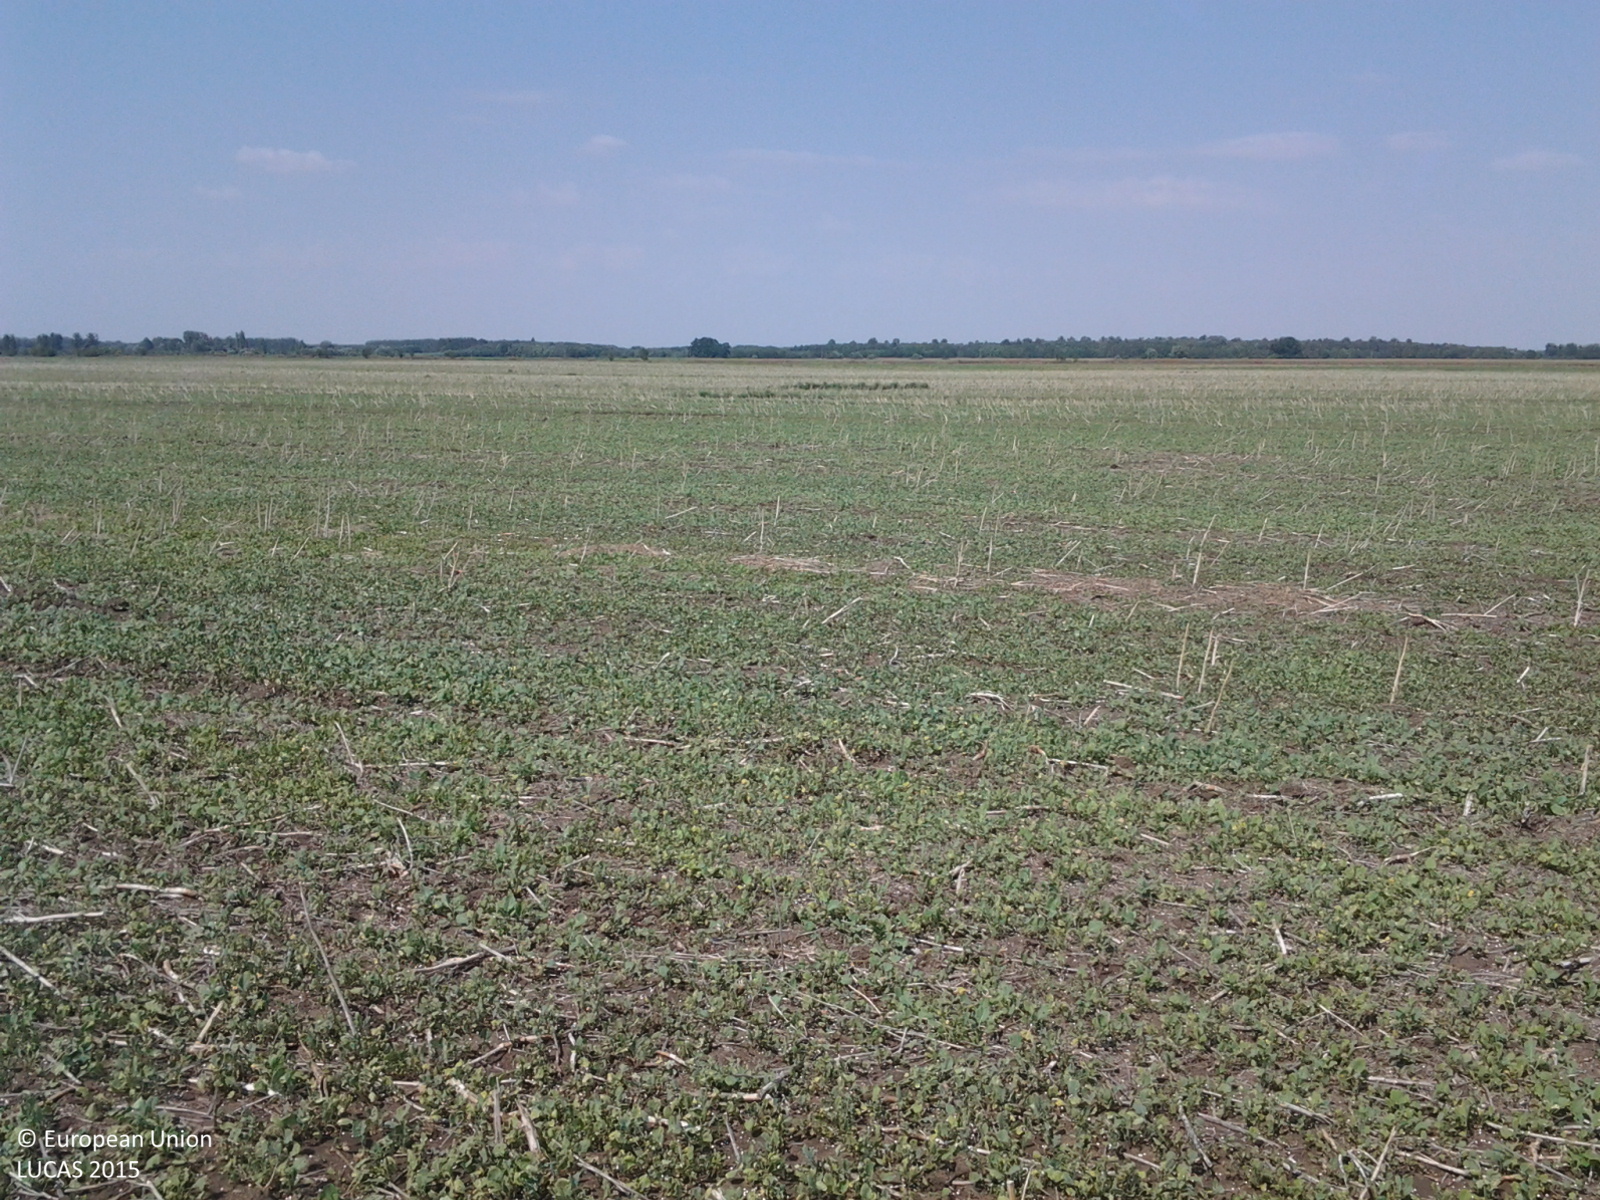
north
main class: Cropland
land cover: Other fibre and oleaginous crops
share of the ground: > 75 %
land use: Agriculture (excluding fallow land and kitchen gardens)
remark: Harvested field
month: August
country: HU
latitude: 47.3407
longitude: 19.9113
